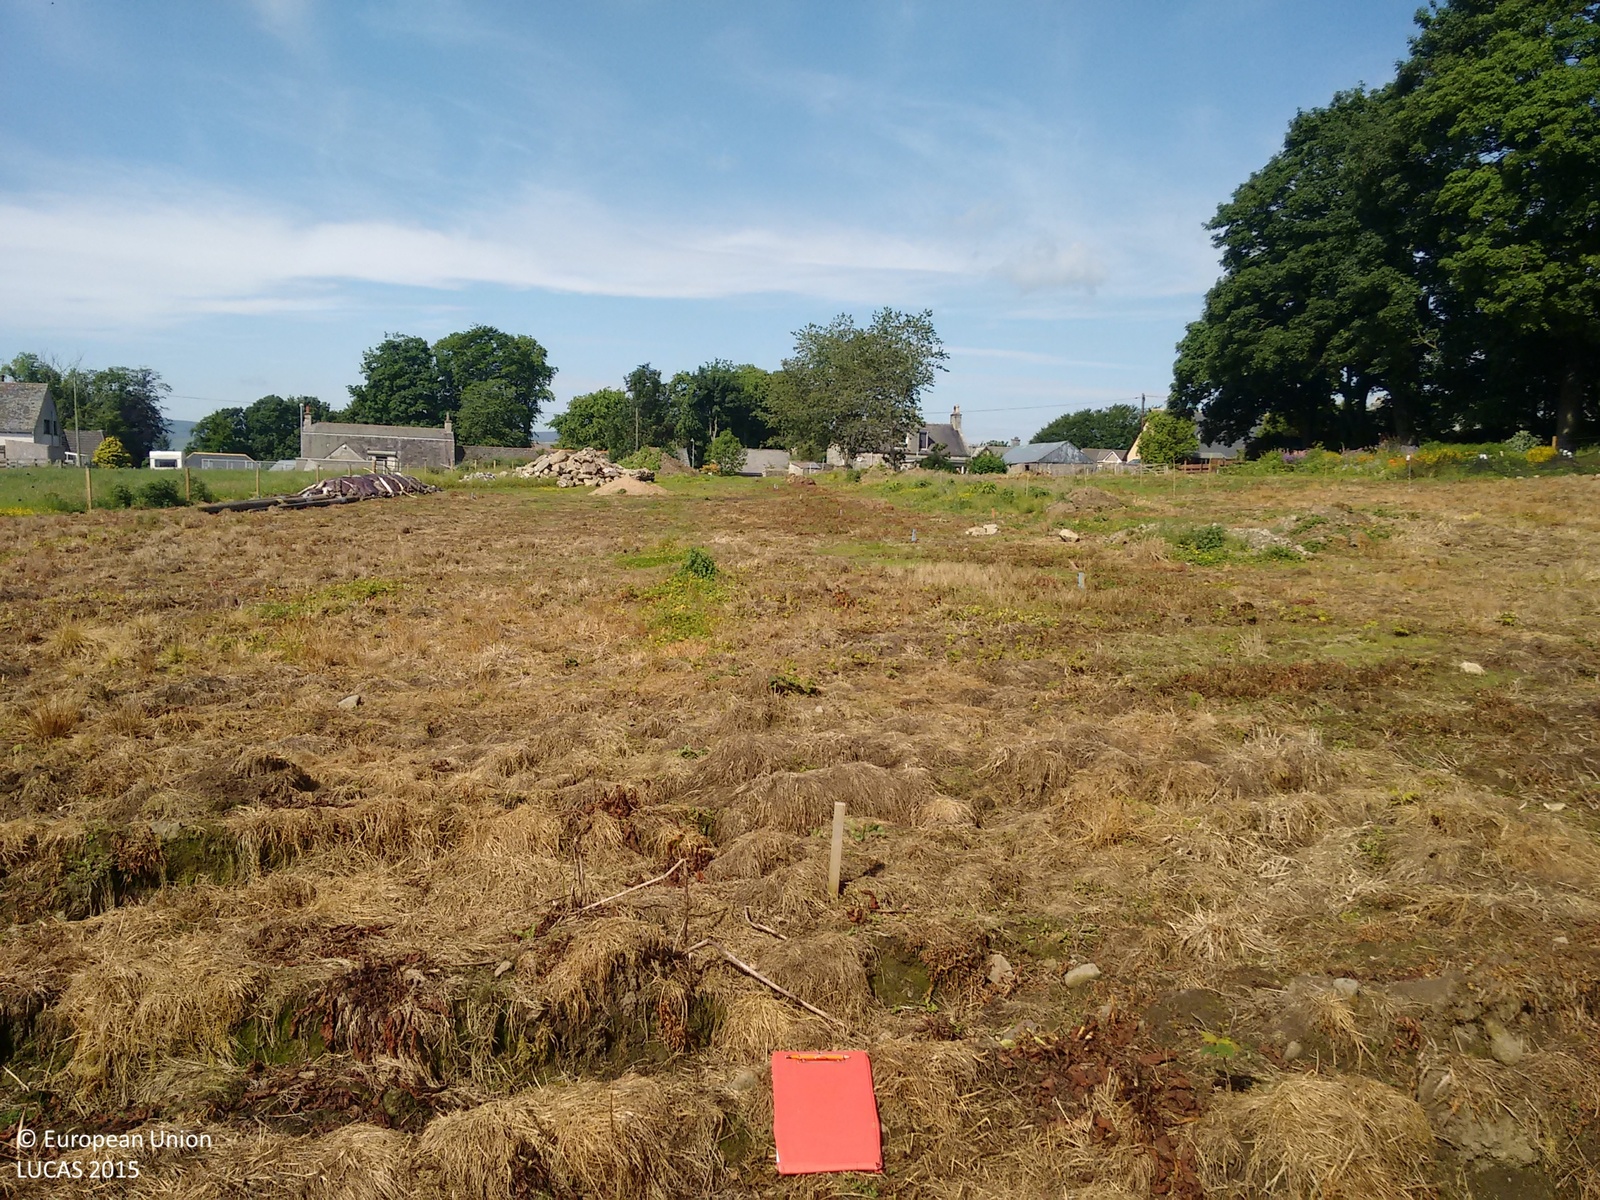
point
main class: Grassland
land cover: Spontaneously vegetated surfaces
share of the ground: > 75 %
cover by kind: unconsolidated bare surface 75 %, herbaceous plants 20 %, shrubs 5 %
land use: Fallow land
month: July
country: GB
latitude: 57.2488
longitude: -2.7029
